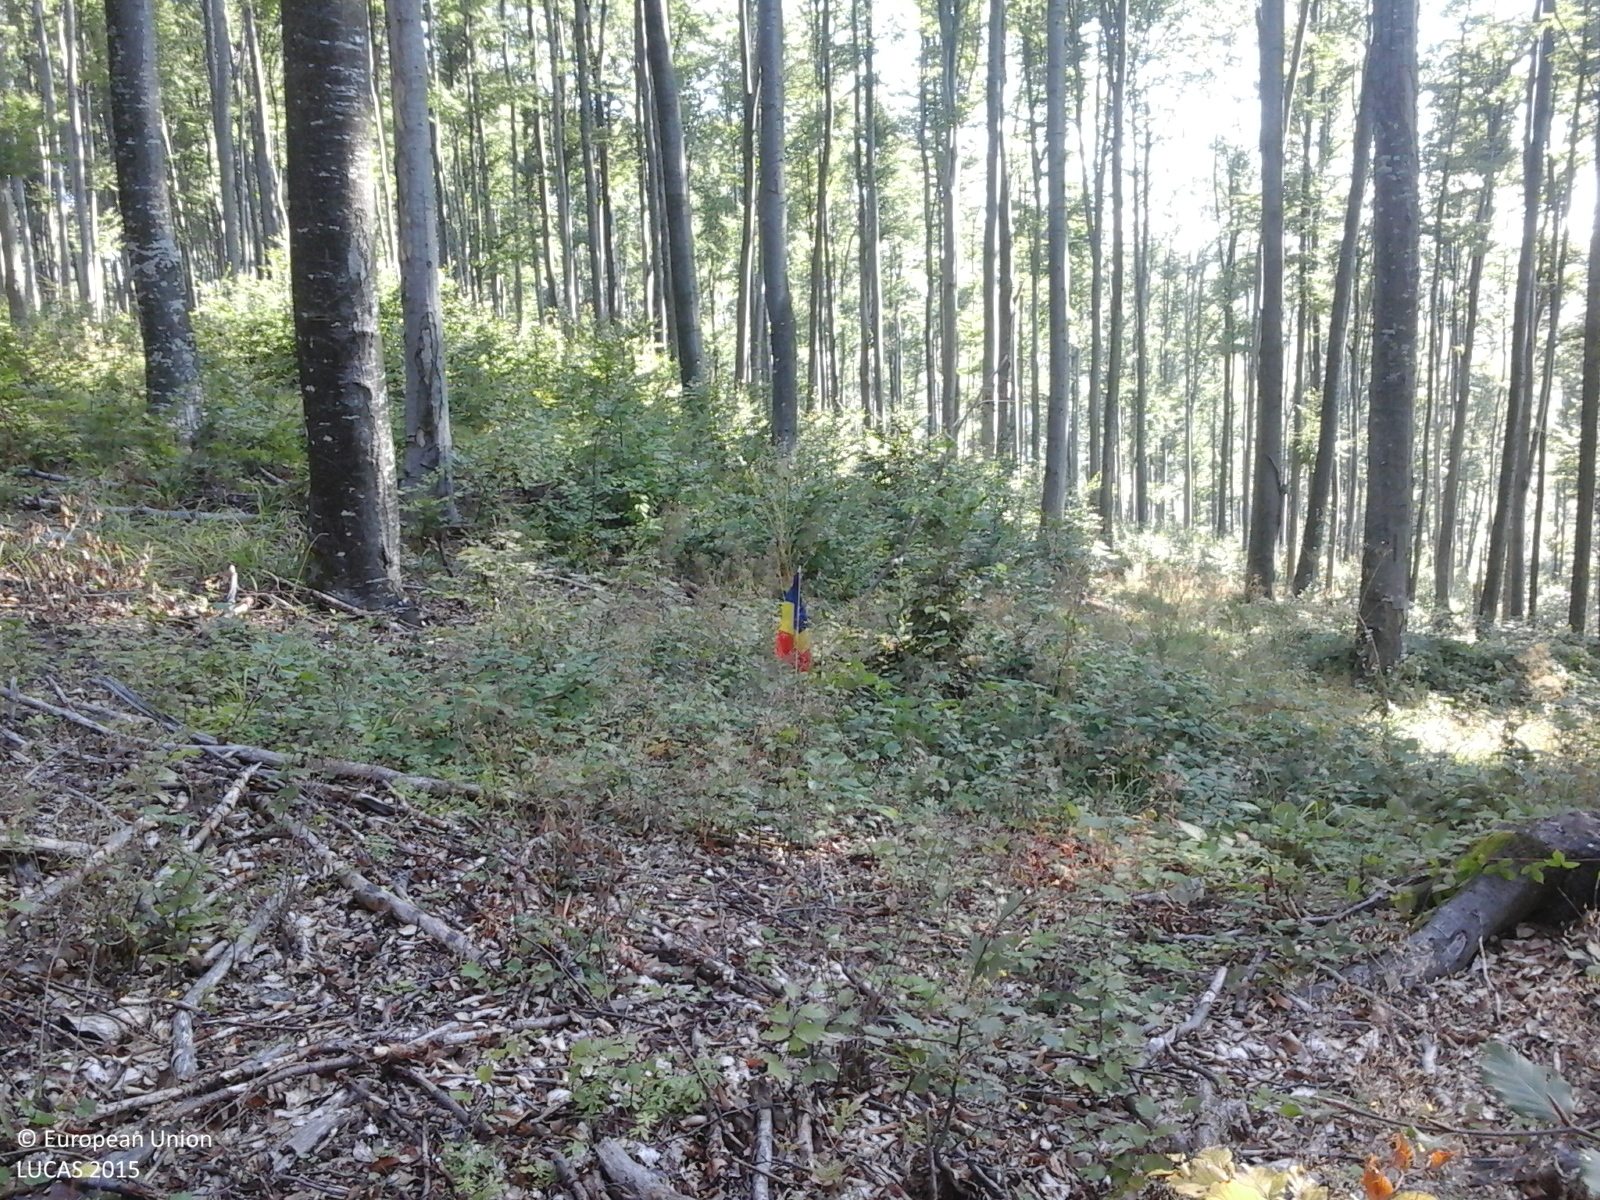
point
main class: Woodland
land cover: Broadleaved woodland
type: beech forest
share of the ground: > 75 %
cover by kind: broadleaved forest trees 100 %
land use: Forestry
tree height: > 5 m
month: September
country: RO
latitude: 47.1310
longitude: 22.4599
